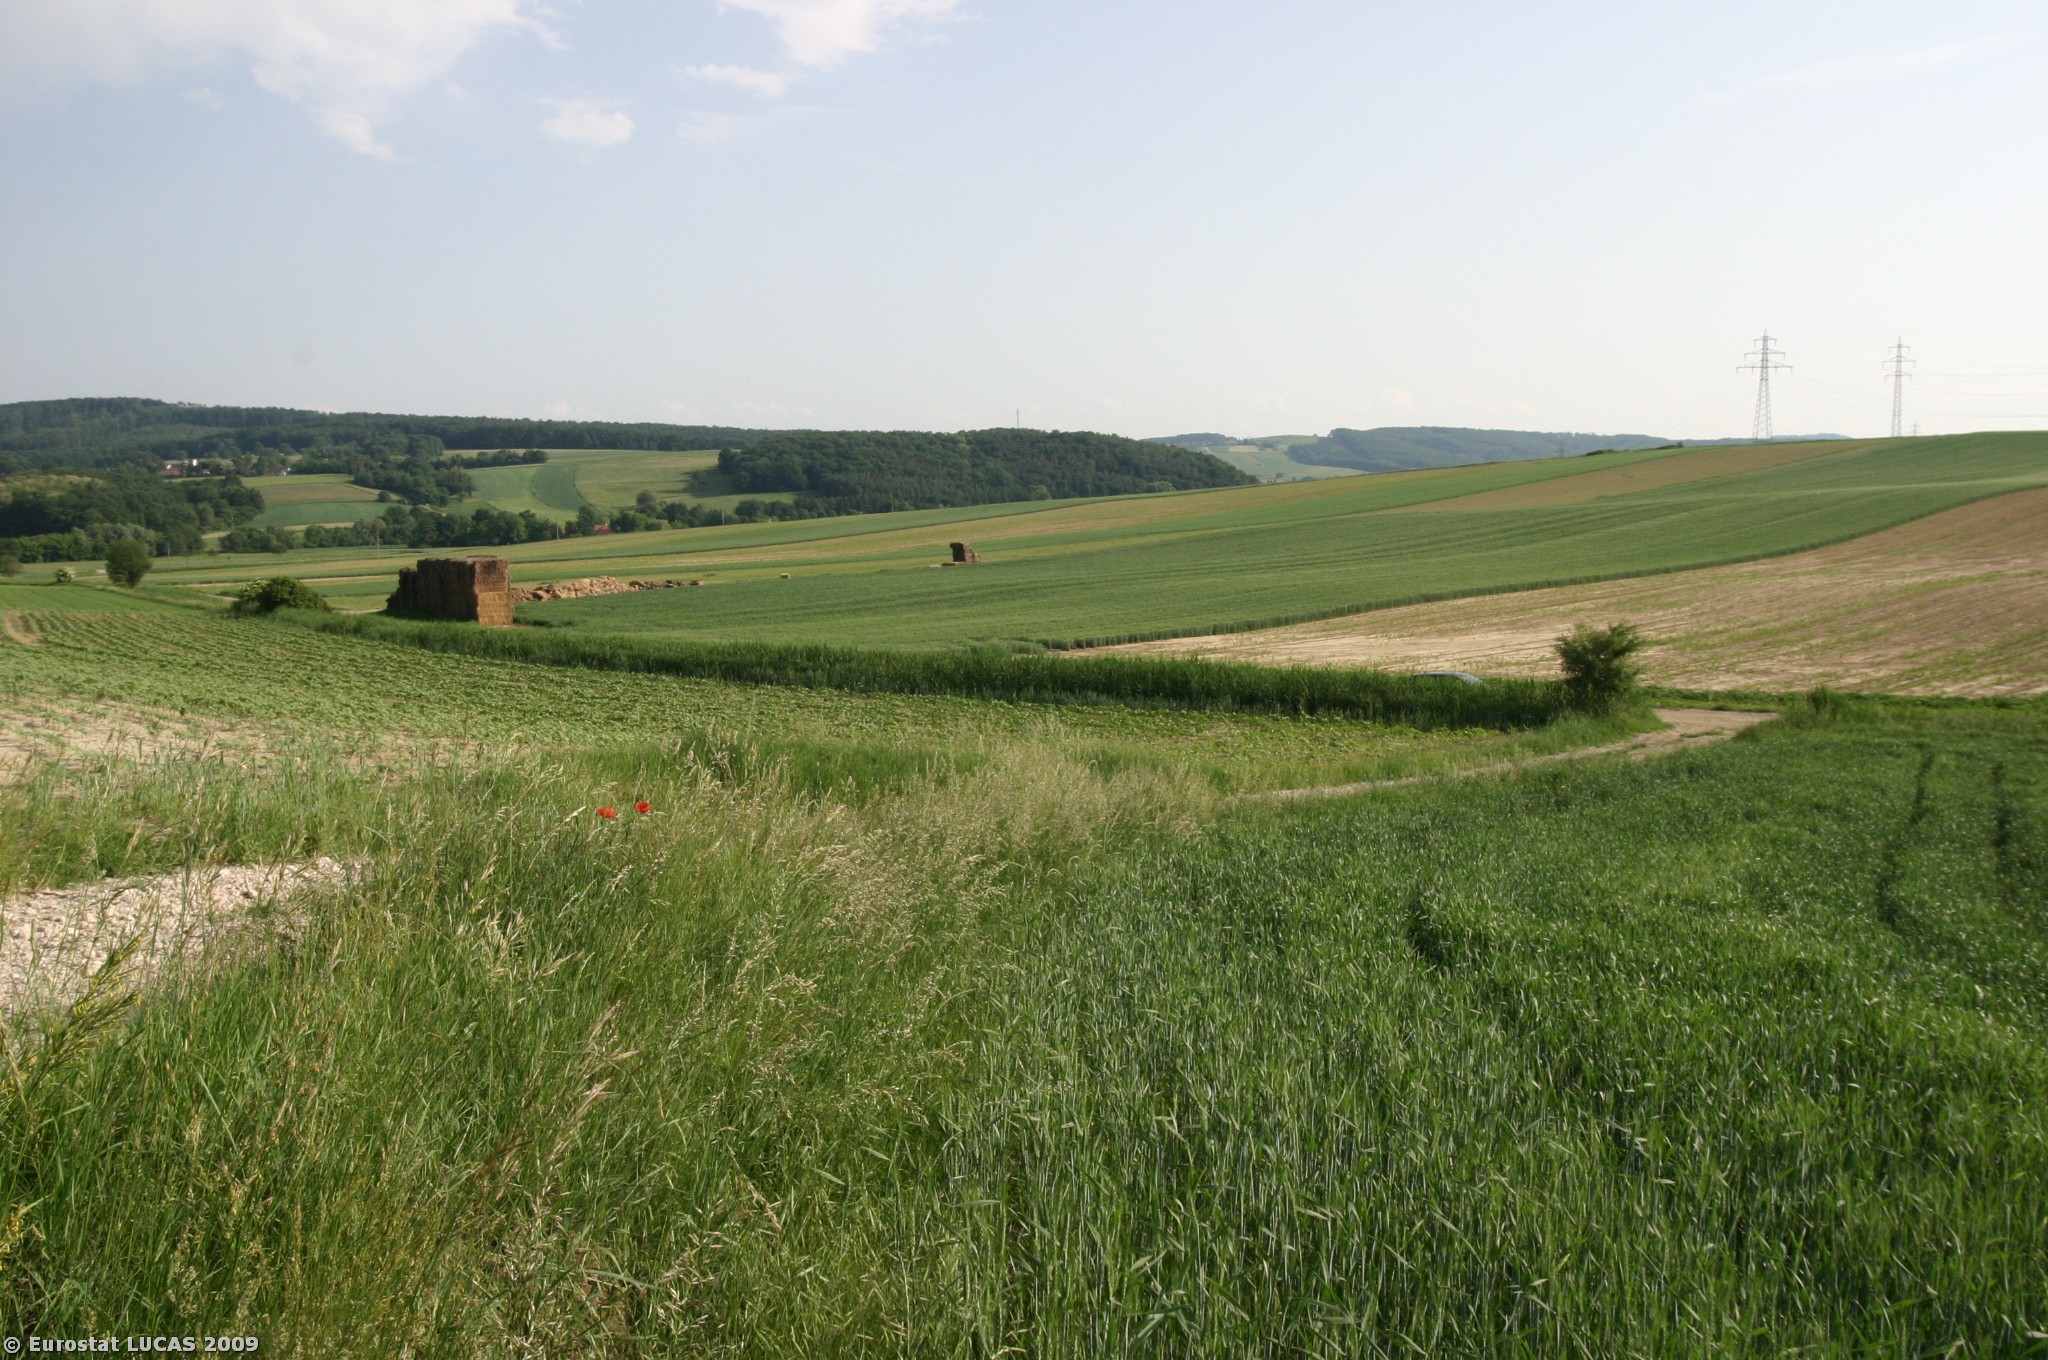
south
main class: Cropland
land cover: Triticale
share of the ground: > 75 %
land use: Agriculture (excluding fallow land and kitchen gardens)
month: May
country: AT
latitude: 48.2408
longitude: 15.9958
